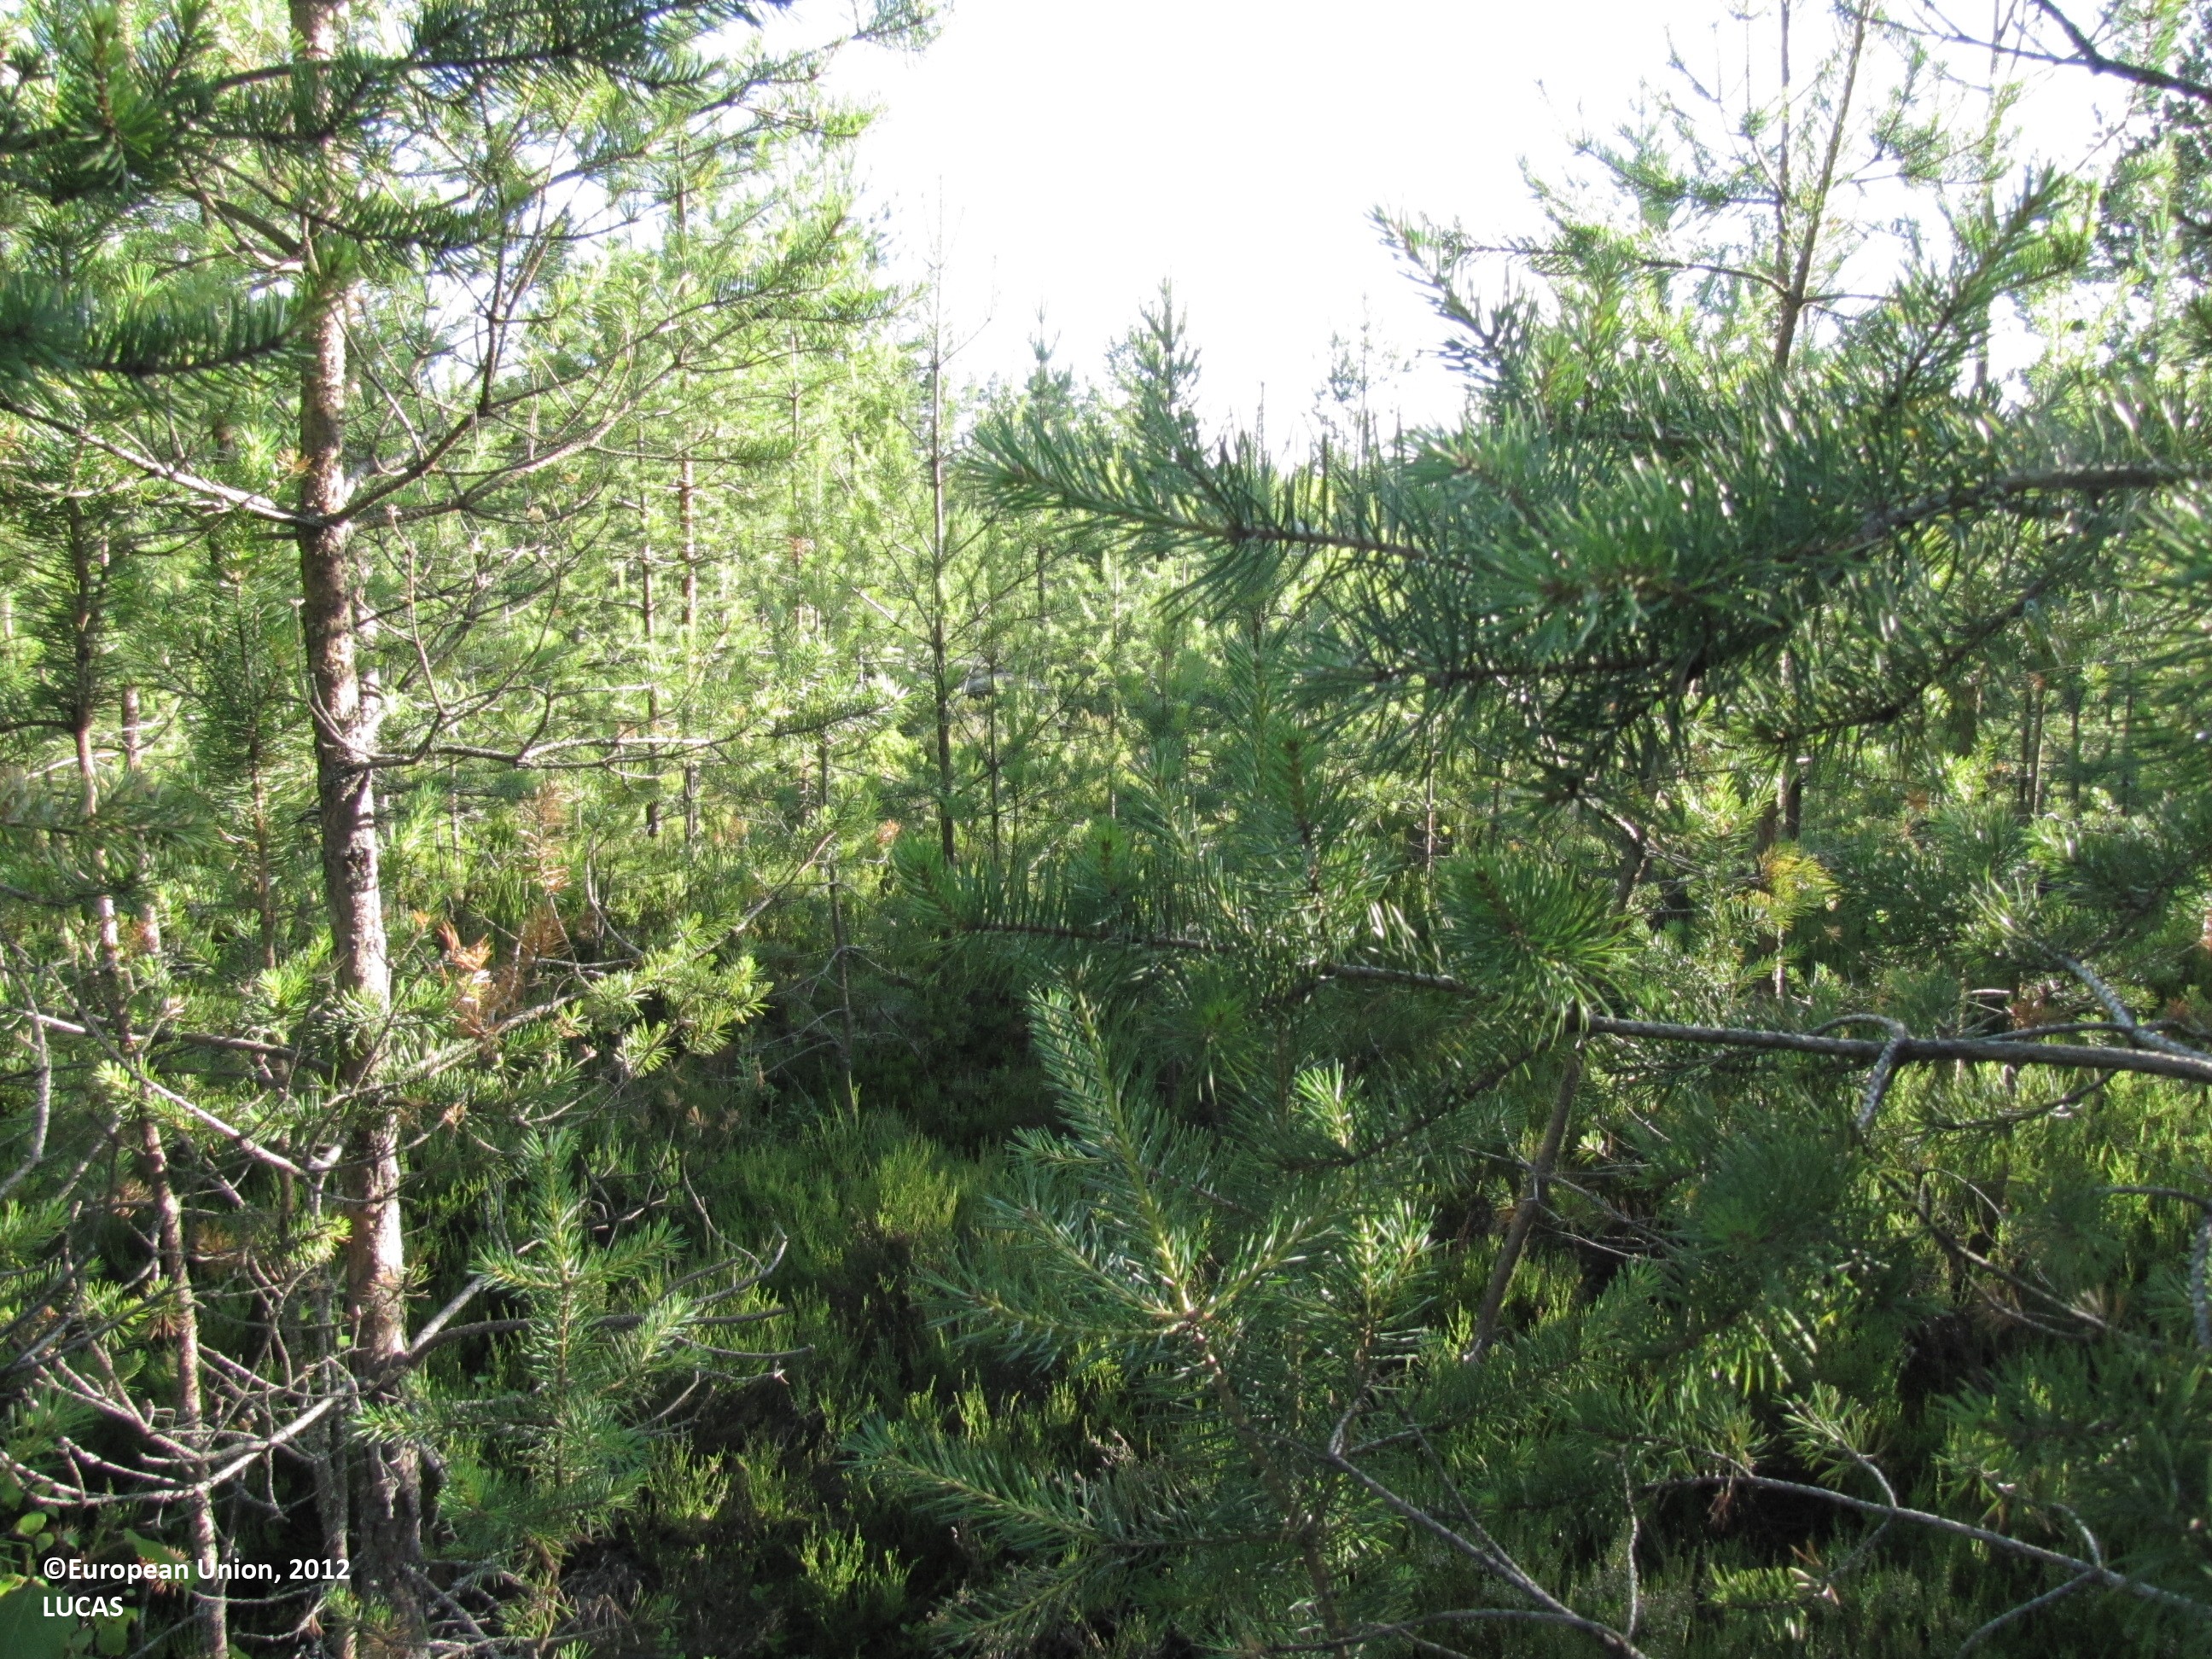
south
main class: Woodland
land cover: Pine dominated coniferous woodland
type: boreal forest
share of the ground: 25 - 50 %
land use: Forestry
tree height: > 5 m
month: July
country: FI
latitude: 62.5213
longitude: 23.2179
